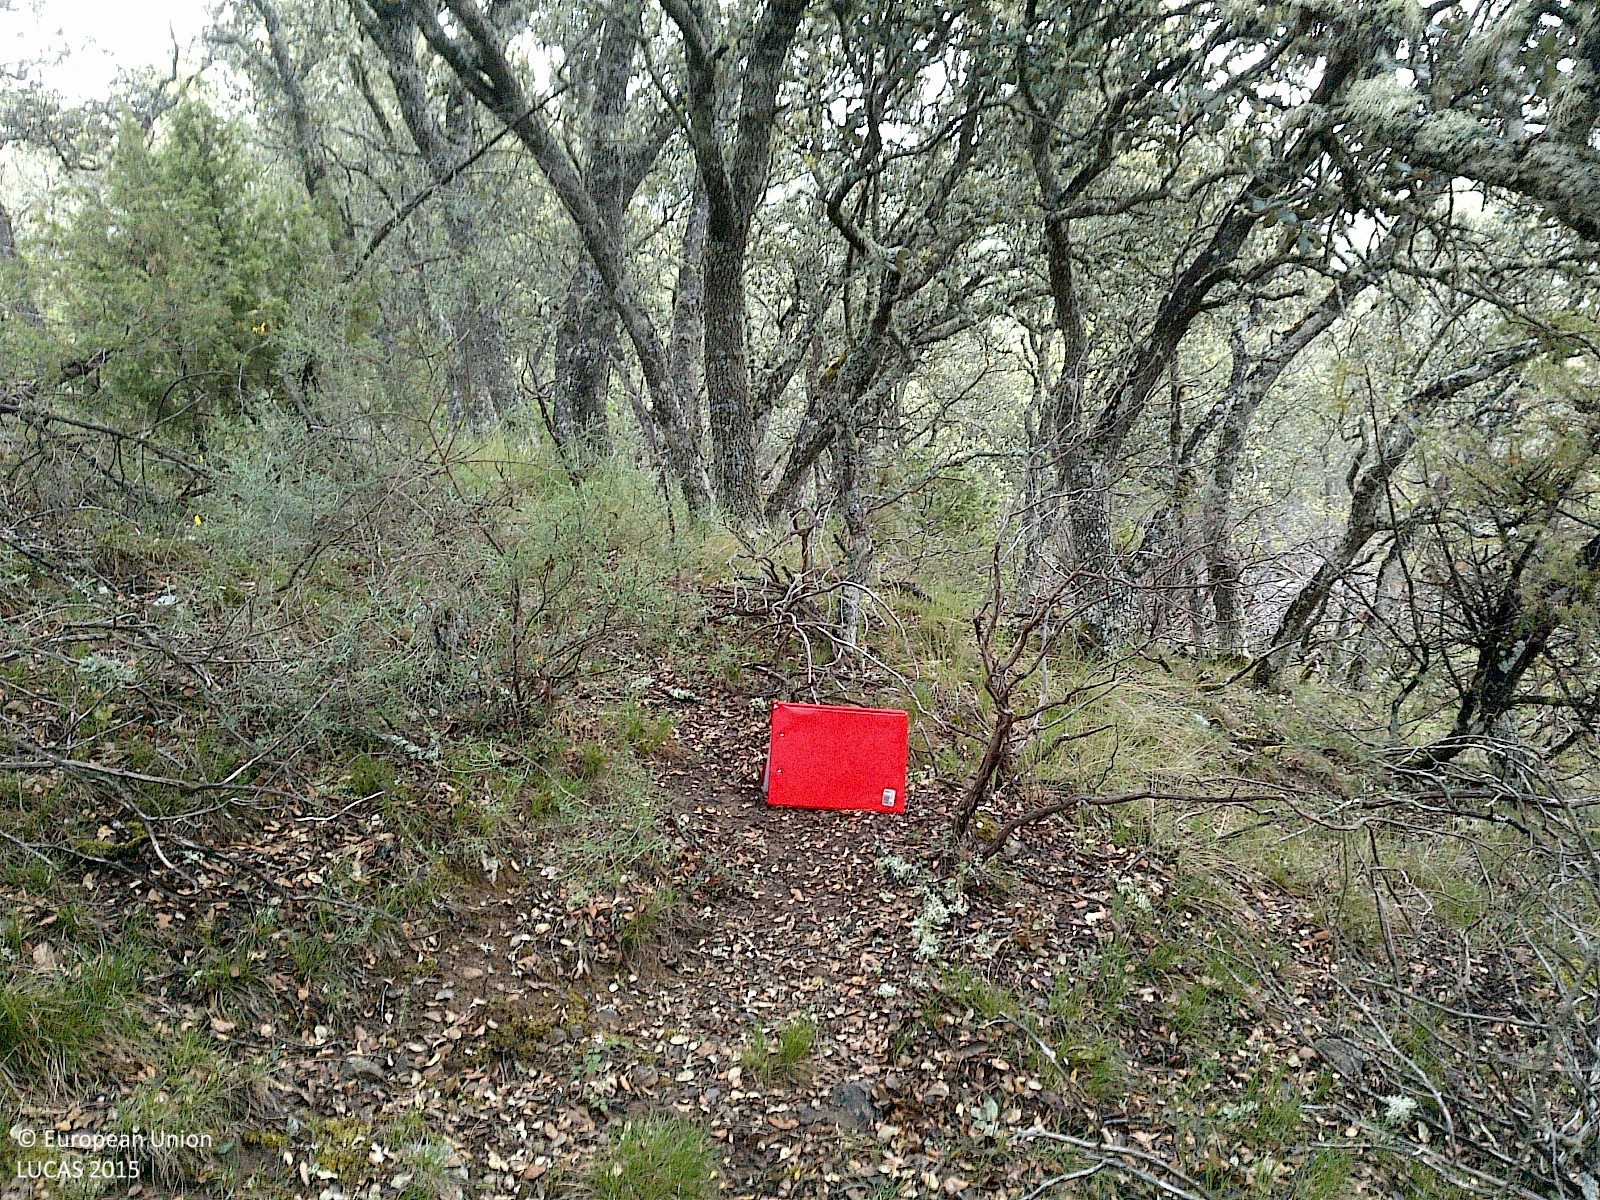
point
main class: Woodland
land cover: Broadleaved woodland
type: broadleaved evergreen forest
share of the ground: > 75 %
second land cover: Grassland without tree/shrub cover
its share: 25 - 50 %
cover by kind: broadleaved forest trees 80 %, shrubs 15 %, herbaceous plants 5 %
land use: Forestry
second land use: Agriculture (excluding fallow land and kitchen gardens)
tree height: > 5 m
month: May
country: ES
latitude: 41.8065
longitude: -2.1799
